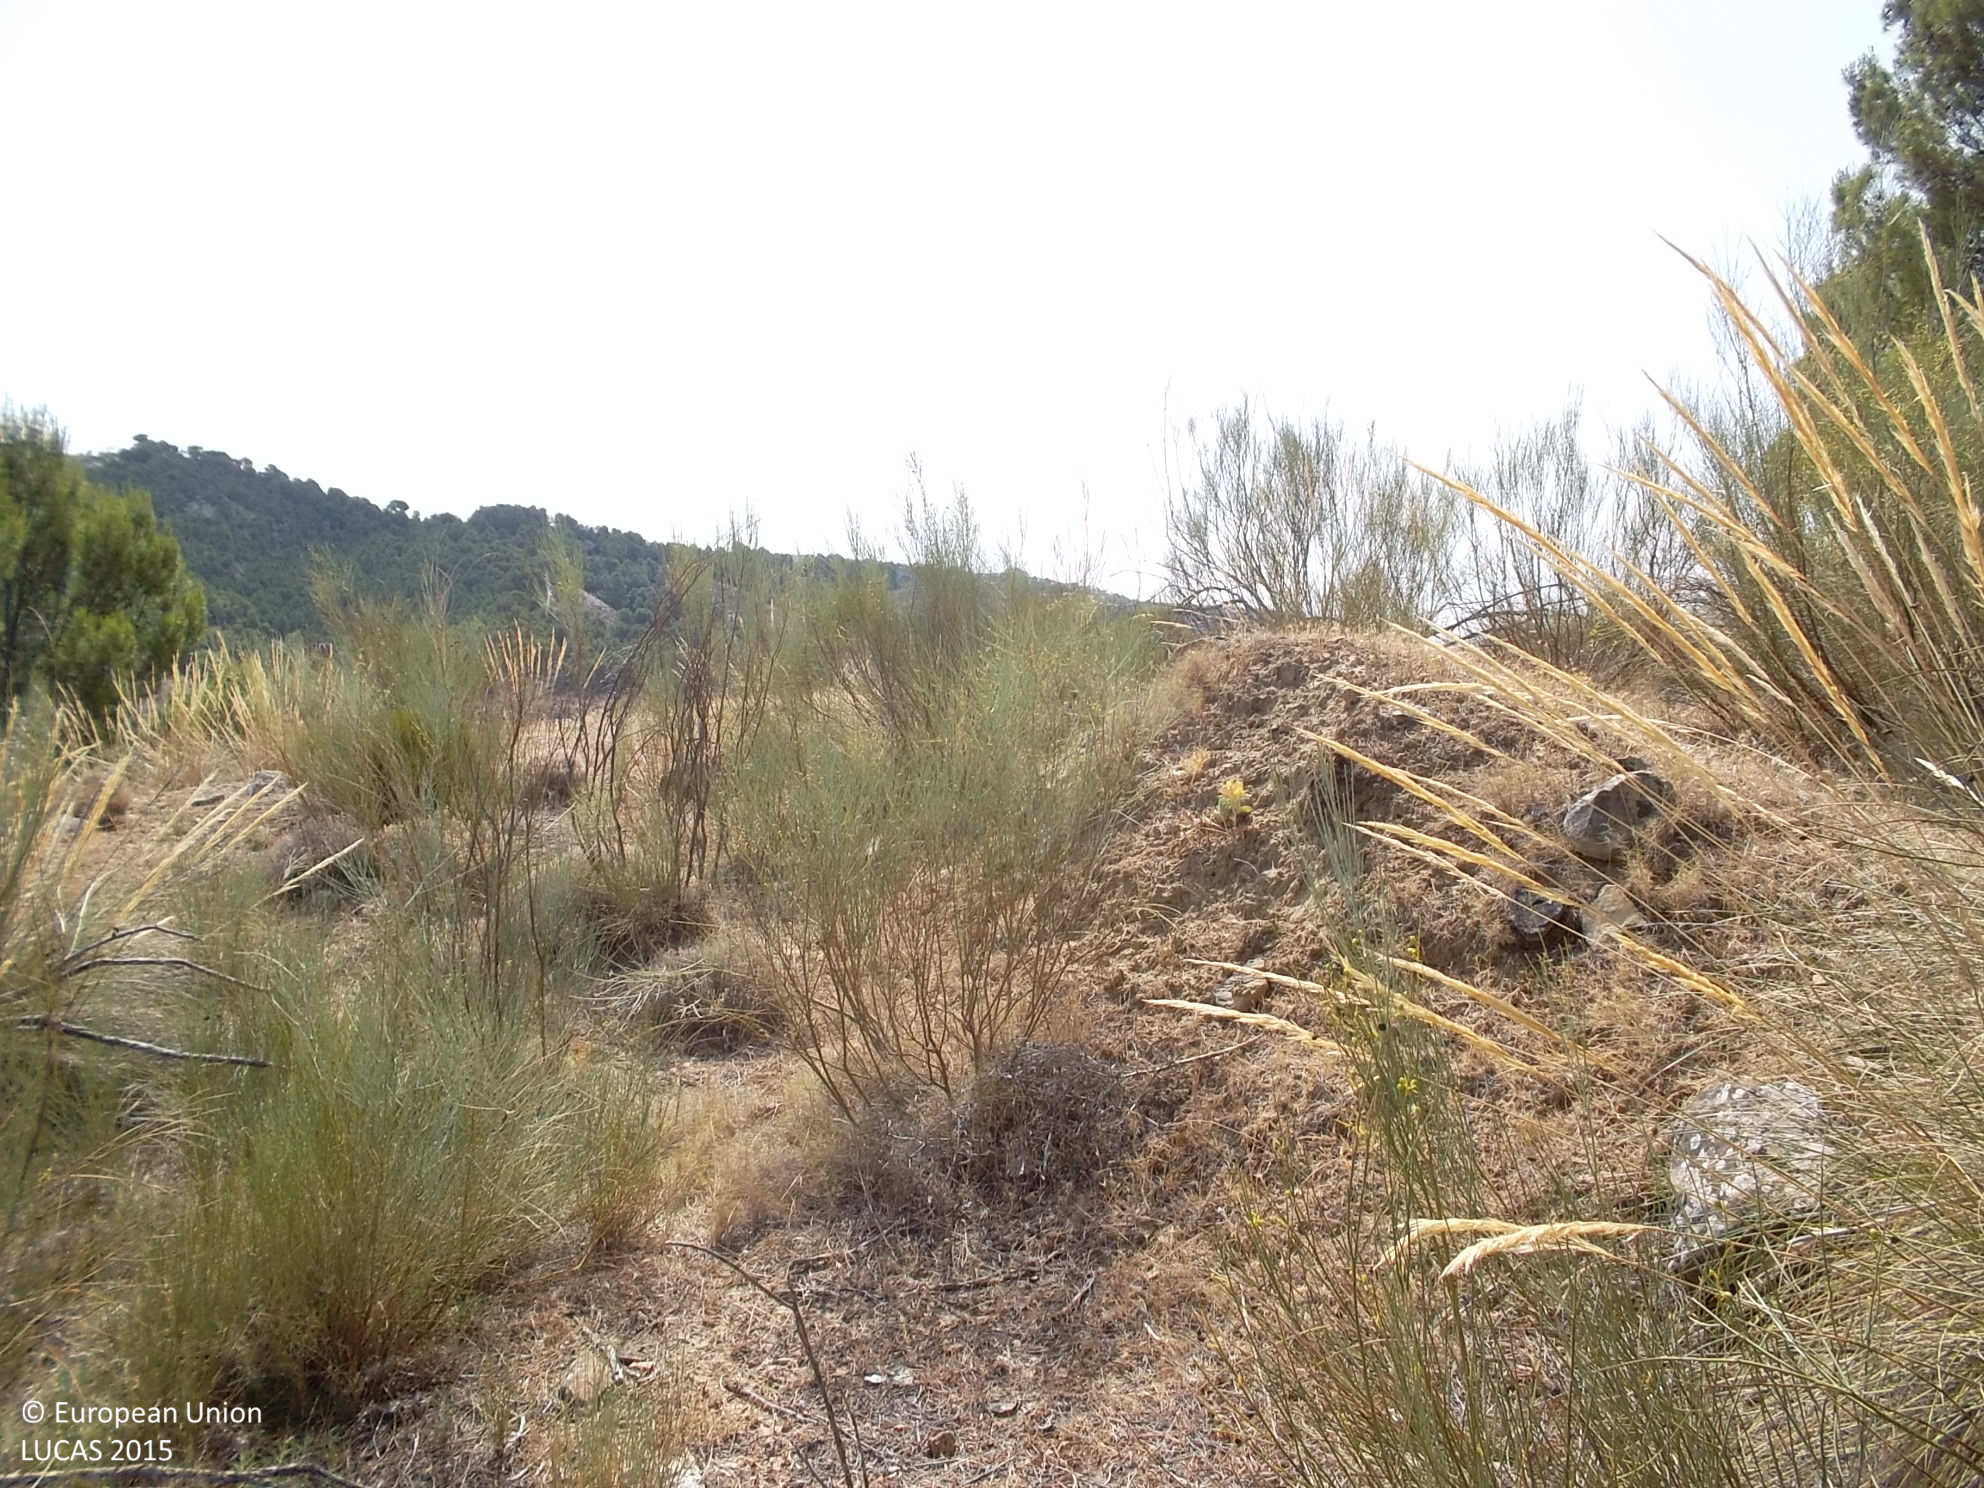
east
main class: Woodland
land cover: Pine dominated coniferous woodland
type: coniferous forest of the mediterranean region
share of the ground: 25 - 50 %
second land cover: Shrubland without tree cover
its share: 25 - 50 %
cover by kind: coniferous forest trees 40 %, shrubs 40 %, herbaceous plants 20 %
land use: Forestry
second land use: Agriculture (excluding fallow land and kitchen gardens)
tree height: > 5 m
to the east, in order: Pine dominated coniferous woodland; Shrubland without tree cover; Grassland without tree/shrub cover; Shrubland with sparse tree cover; Rivers and streams; Shrubland without tree cover; Grassland without tree/shrub cover; Tracks; Mixed cereals for fodder
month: July
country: ES
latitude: 37.7191
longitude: -2.8217
